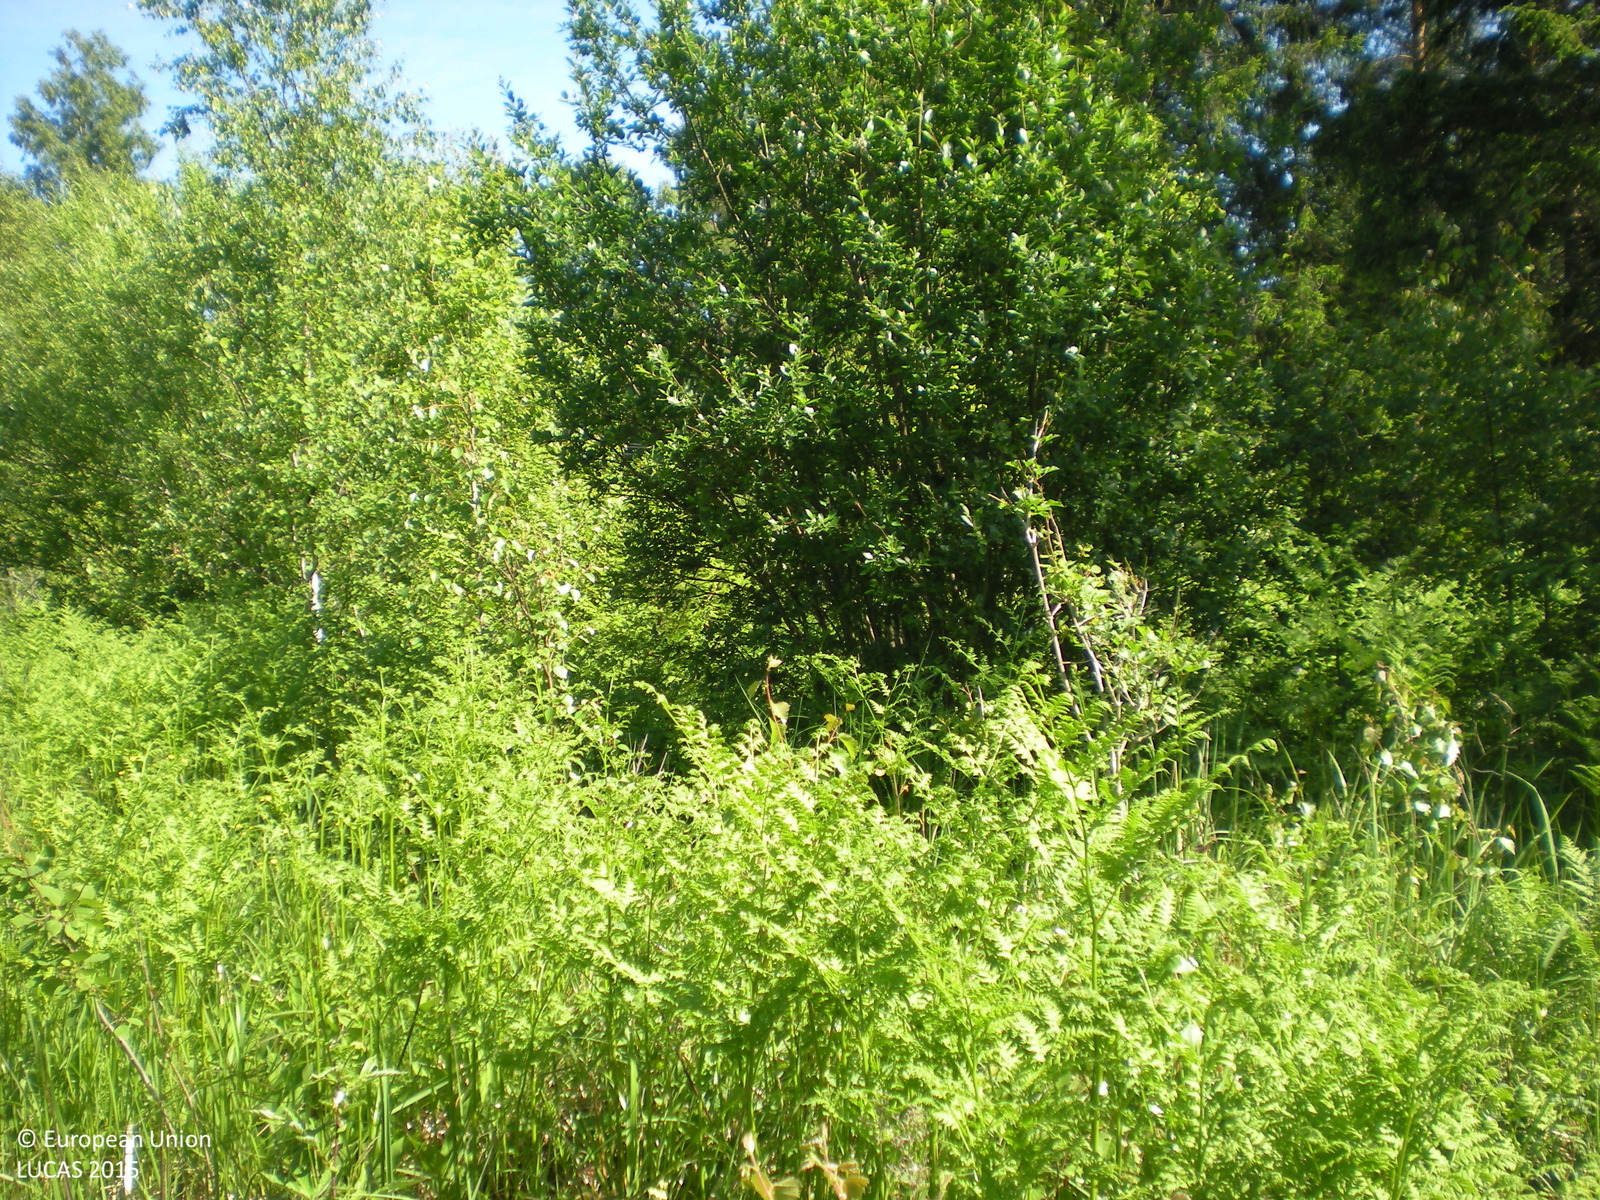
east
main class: Grassland
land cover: Grassland with sparse tree/shrub cover
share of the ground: > 75 %
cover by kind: herbaceous plants 85 %, shrubs 10 %, broadleaved forest trees 5 %
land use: Electricity, gas and thermal power distribution
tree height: < 5 m
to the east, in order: Grassland with sparse tree/shrub cover; Electric lines; Grassland with sparse tree/shrub cover; Broadleaved woodland; Grass margins; Ditches and canals; Grass margins; Paved roads, cycling and walking lanes; Grassland with sparse tree/shrub cover; Ditches and canals; Paved roads, cycling and walking lanes; Ditches and canals; Grassland with sparse tree/shrub cover; Spruce dominated mixed woodland; Pine dominated mixed woodland; Pine dominated coniferous woodland
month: July
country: SE
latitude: 60.5909
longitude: 17.9336
